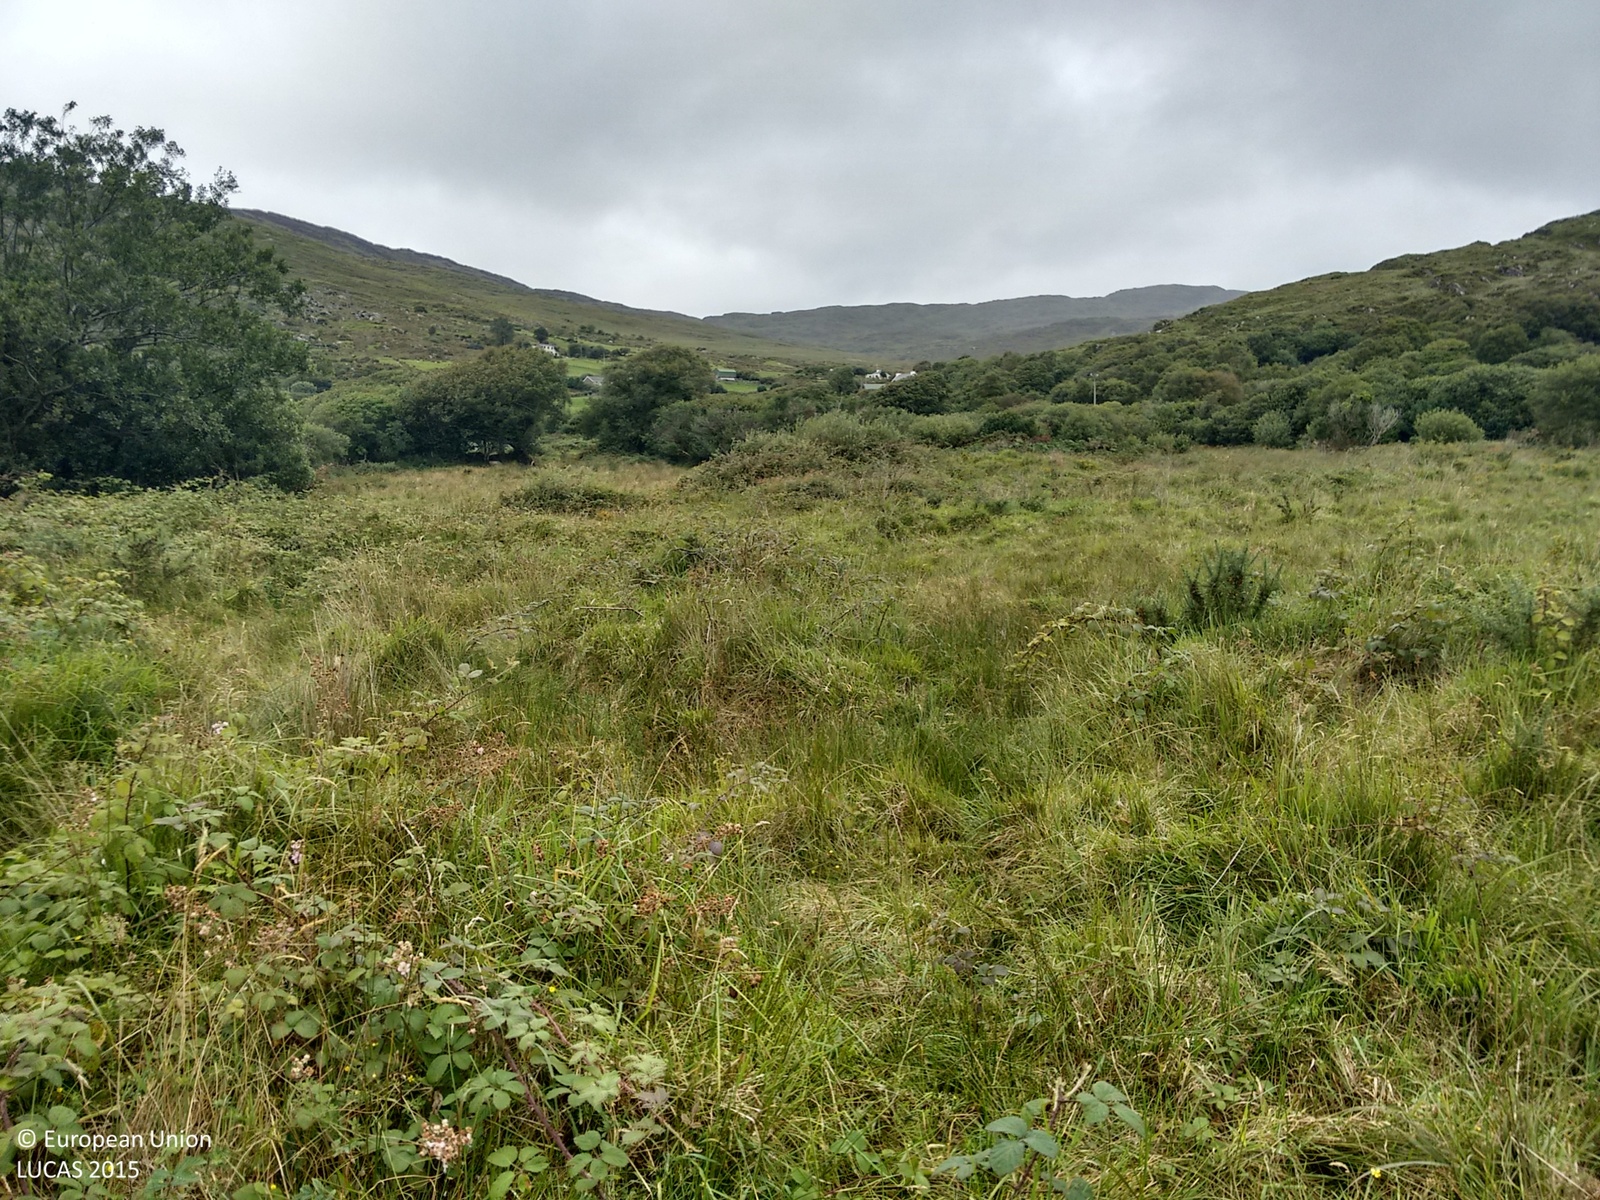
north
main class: Grassland
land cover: Grassland with sparse tree/shrub cover
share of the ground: > 75 %
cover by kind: herbaceous plants 85 %, shrubs 10 %, broadleaved forest trees 5 %
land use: Agriculture (excluding fallow land and kitchen gardens)
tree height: < 5 m
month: August
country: IE
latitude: 51.7963
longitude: -10.0181
